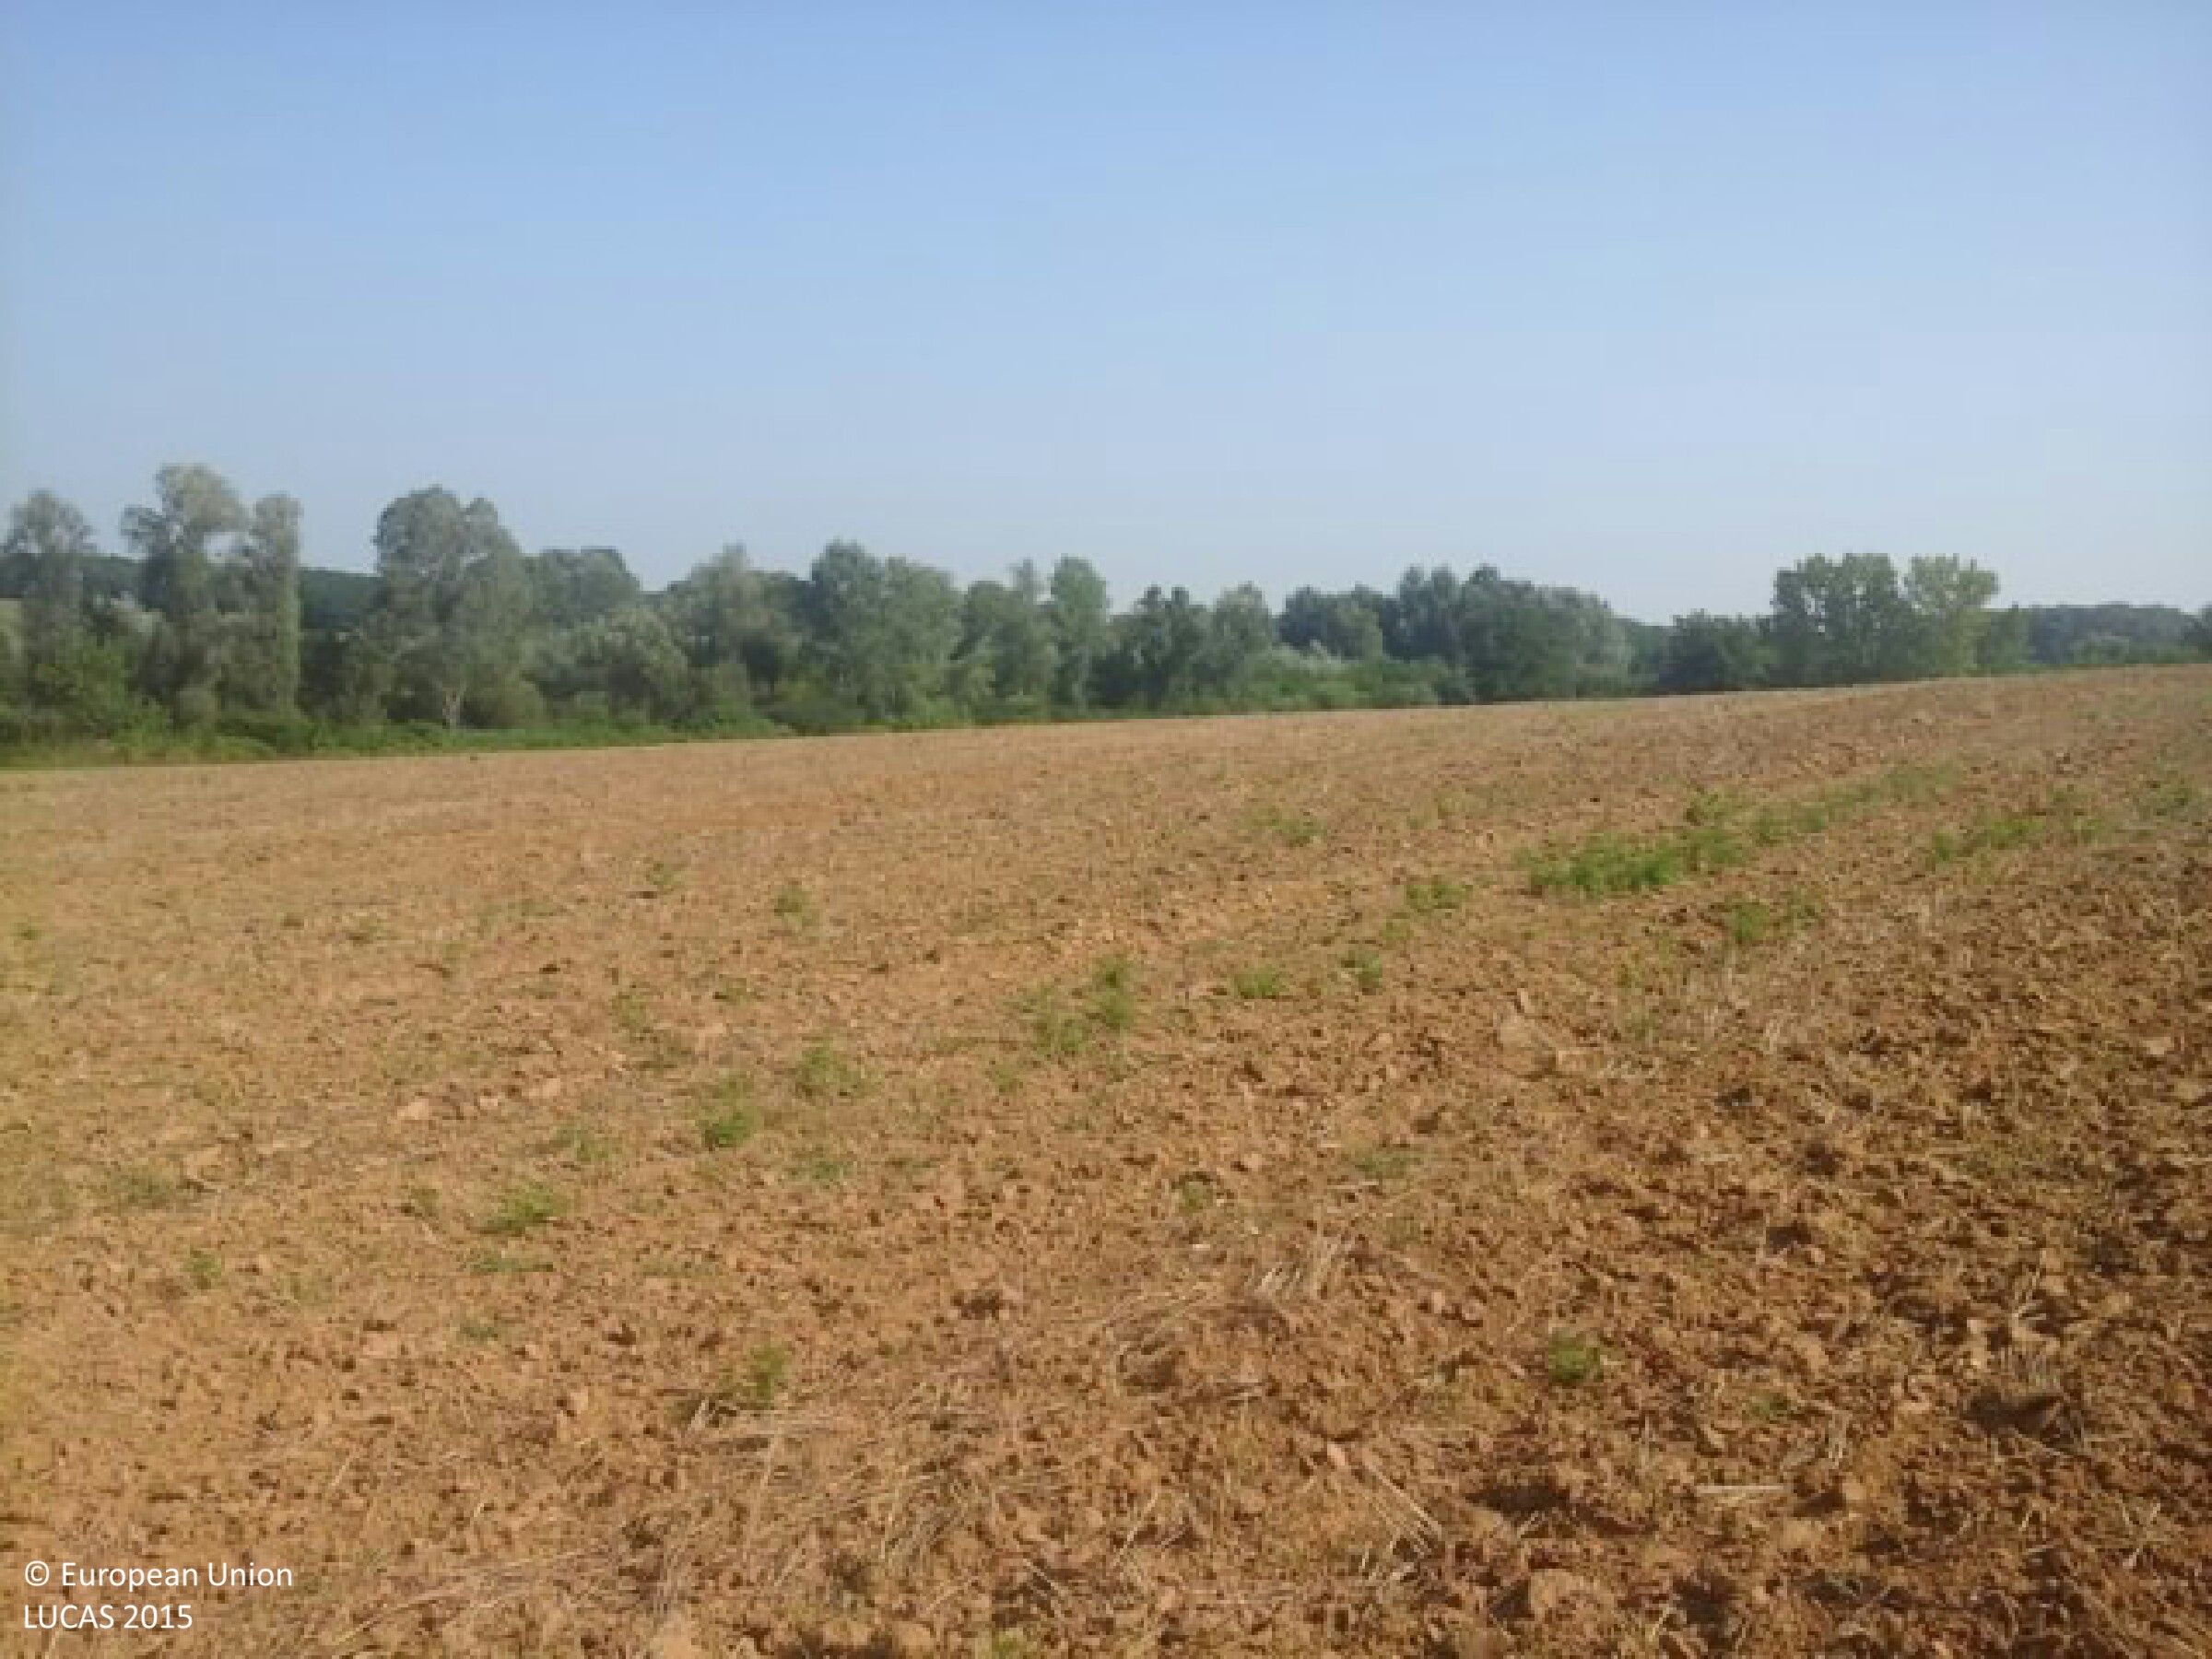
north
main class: Cropland
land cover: Triticale
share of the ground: < 10 %
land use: Agriculture (excluding fallow land and kitchen gardens)
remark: Harvested field
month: August
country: HU
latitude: 46.3611
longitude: 18.2093
